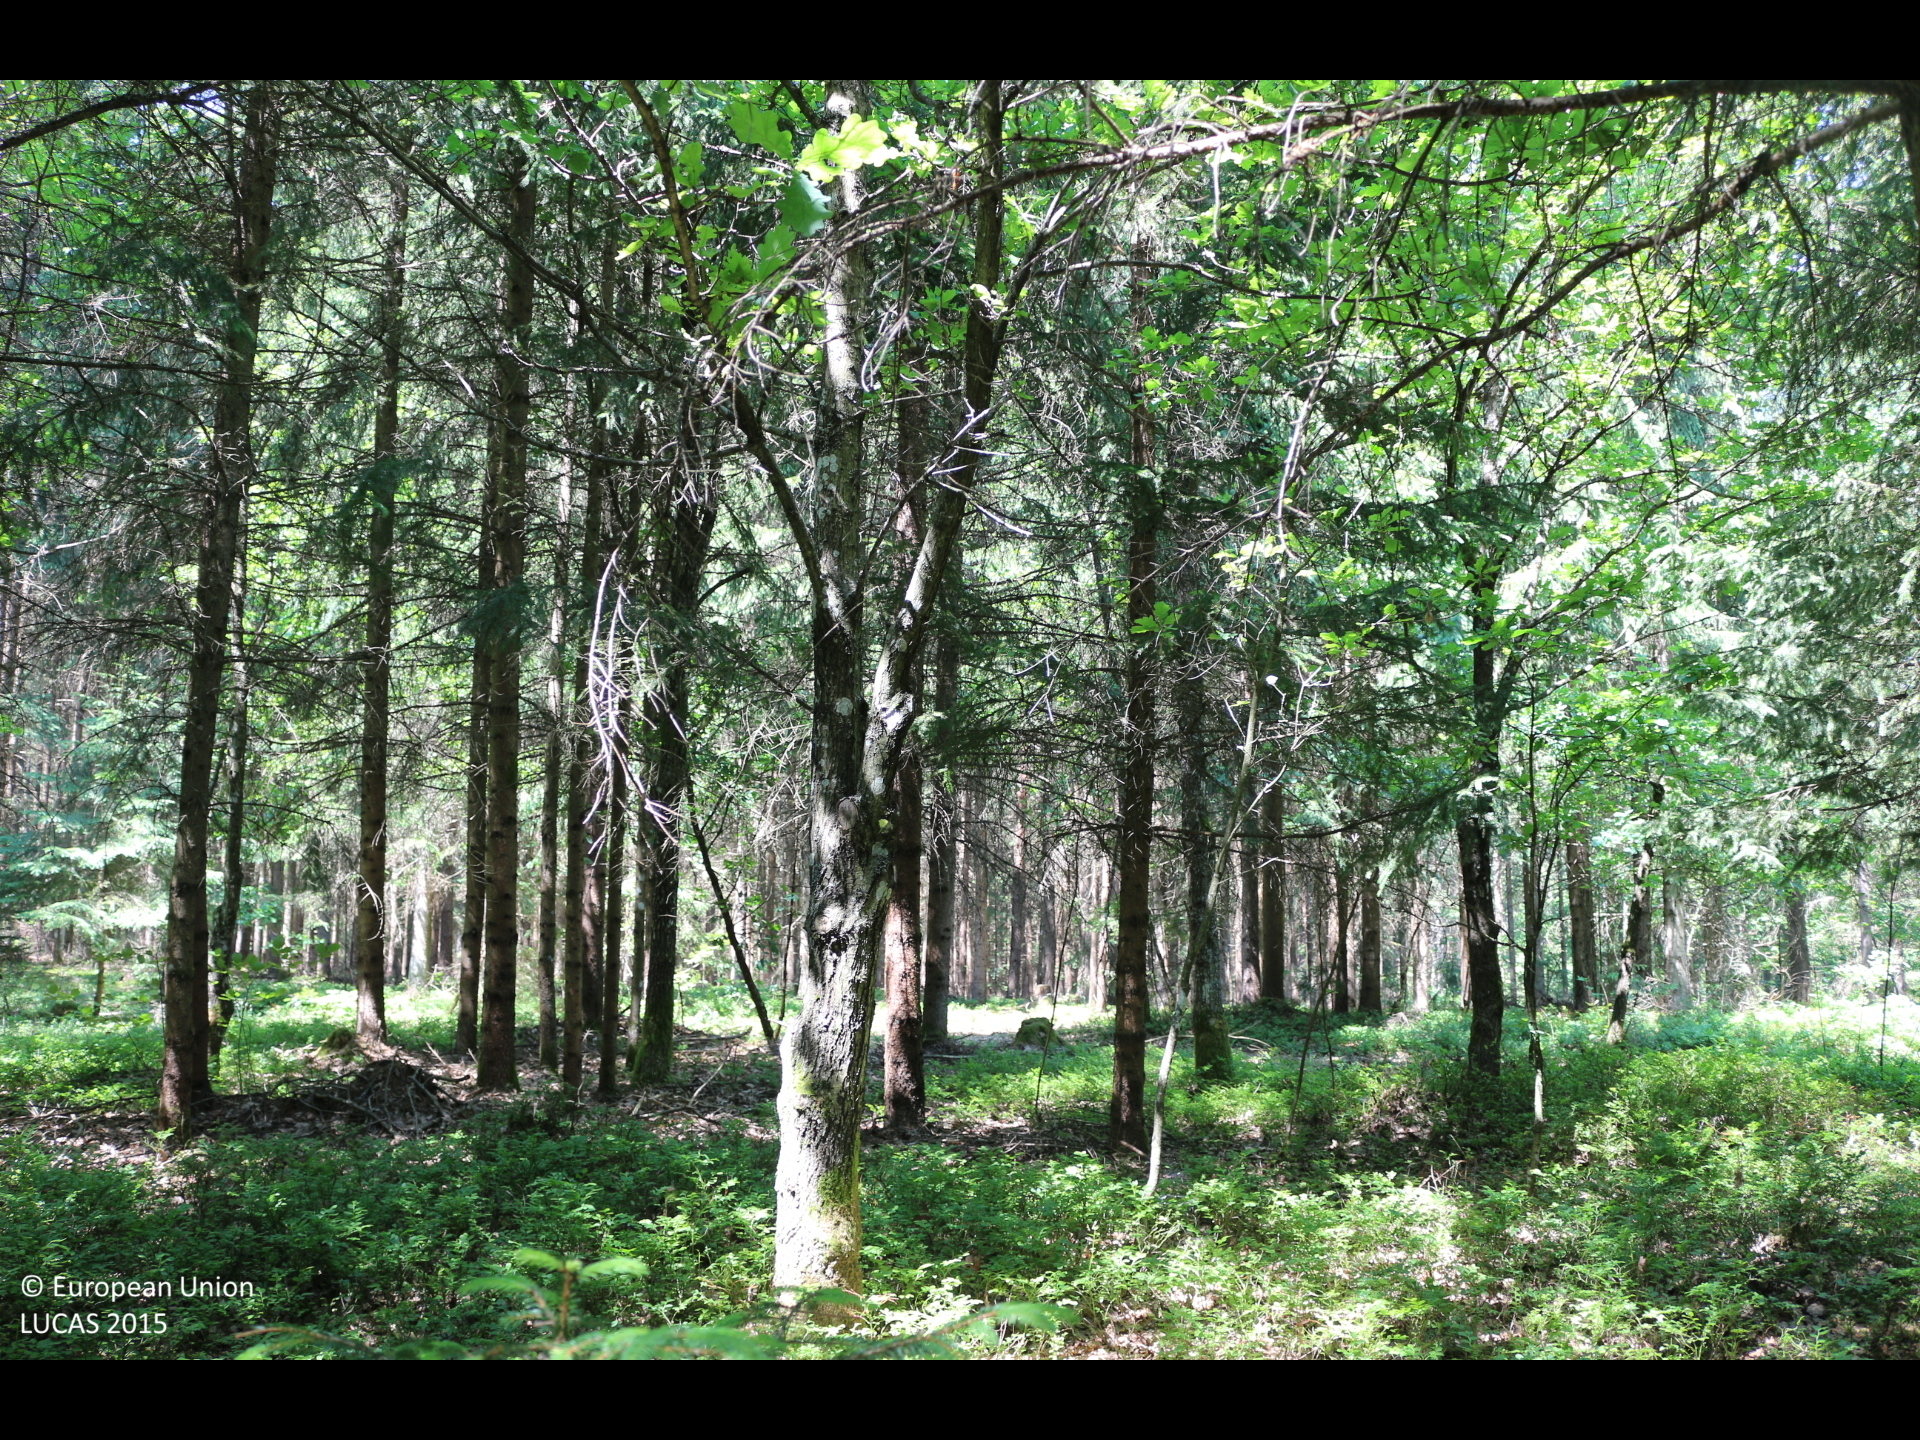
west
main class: Woodland
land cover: Spruce dominated coniferous woodland
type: alpine coniferous forest
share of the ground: > 75 %
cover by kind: coniferous forest trees 90 %, broadleaved forest trees 10 %
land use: Forestry
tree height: > 5 m
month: June
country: AT
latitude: 46.7047
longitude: 14.1175
